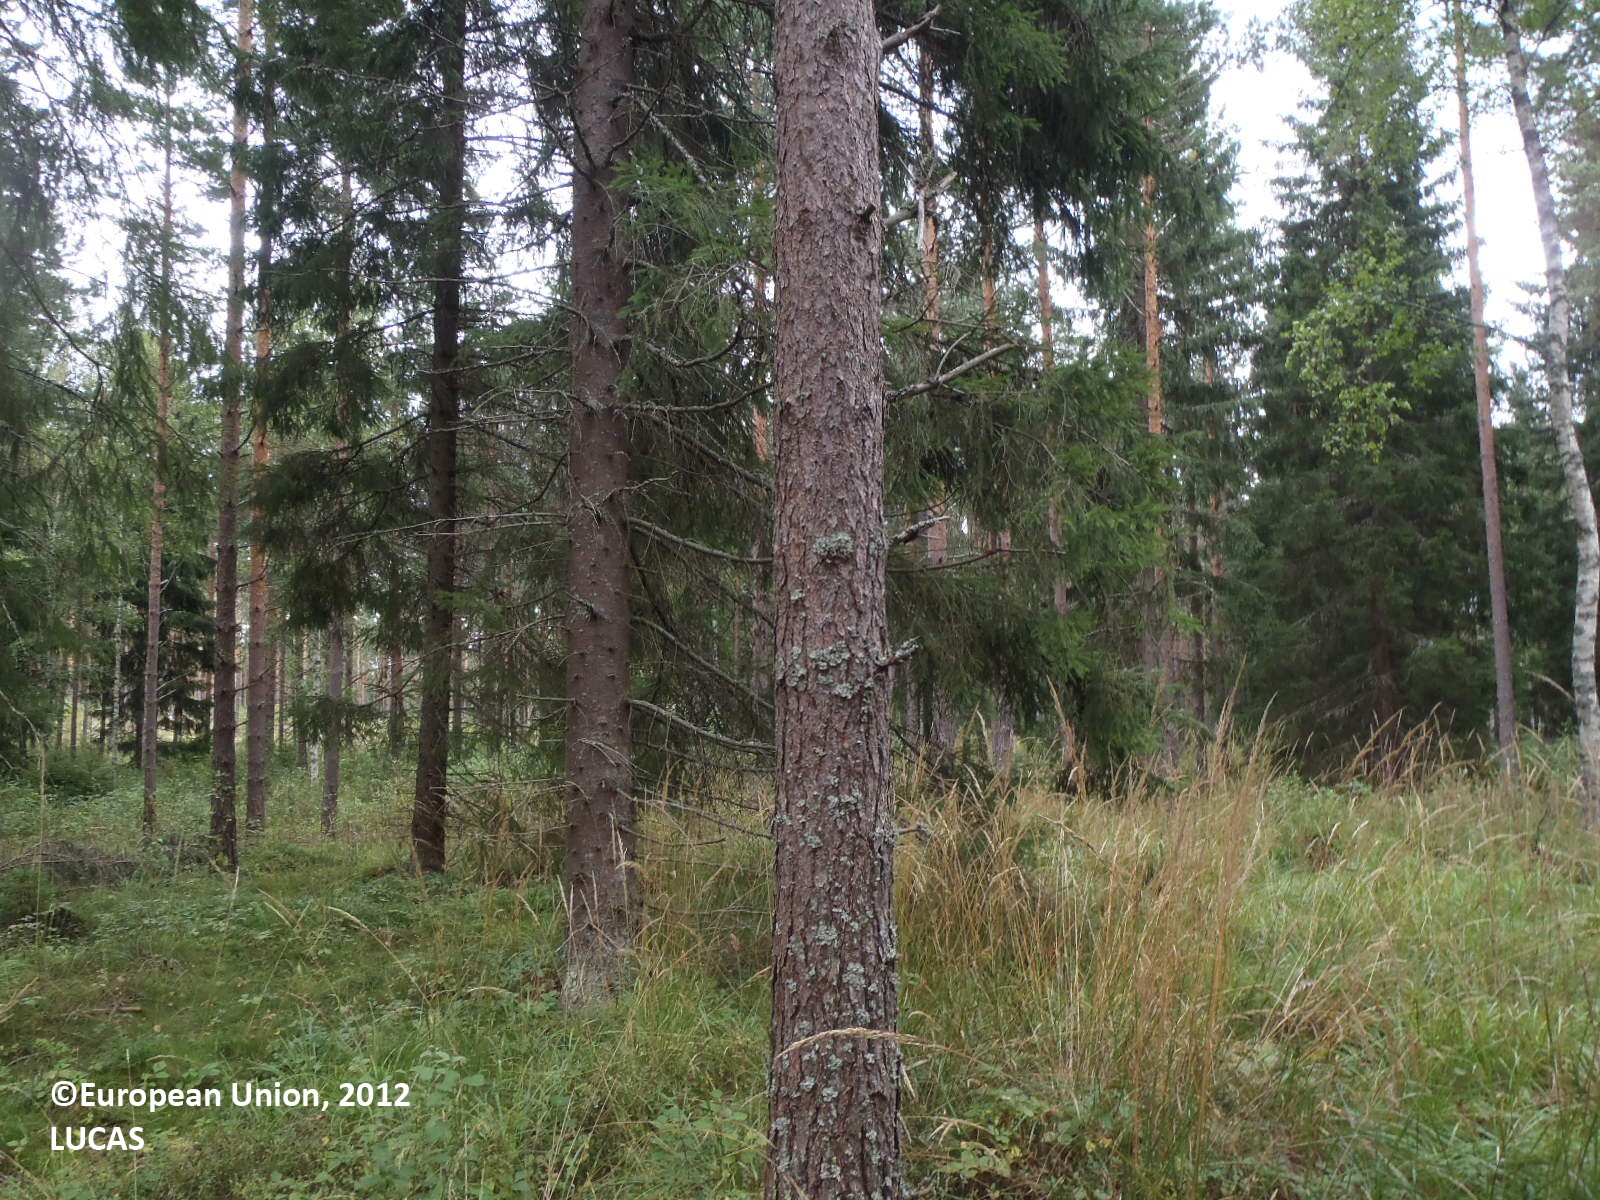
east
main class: Woodland
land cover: Spruce dominated coniferous woodland
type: boreal forest
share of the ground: > 75 %
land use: Forestry
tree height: > 5 m
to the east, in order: Spruce dominated coniferous woodland; Ditches and canals; Spruce dominated coniferous woodland; Ditches and canals; Spruce dominated coniferous woodland; Ditches and canals; Spruce dominated coniferous woodland; Tracks; Spruce dominated coniferous woodland; Electric lines; Ditches and canals; Paved roads, cycling and walking lanes; Ditches and canals; Spruce dominated coniferous woodland
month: August
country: FI
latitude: 60.7146
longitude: 22.3269
